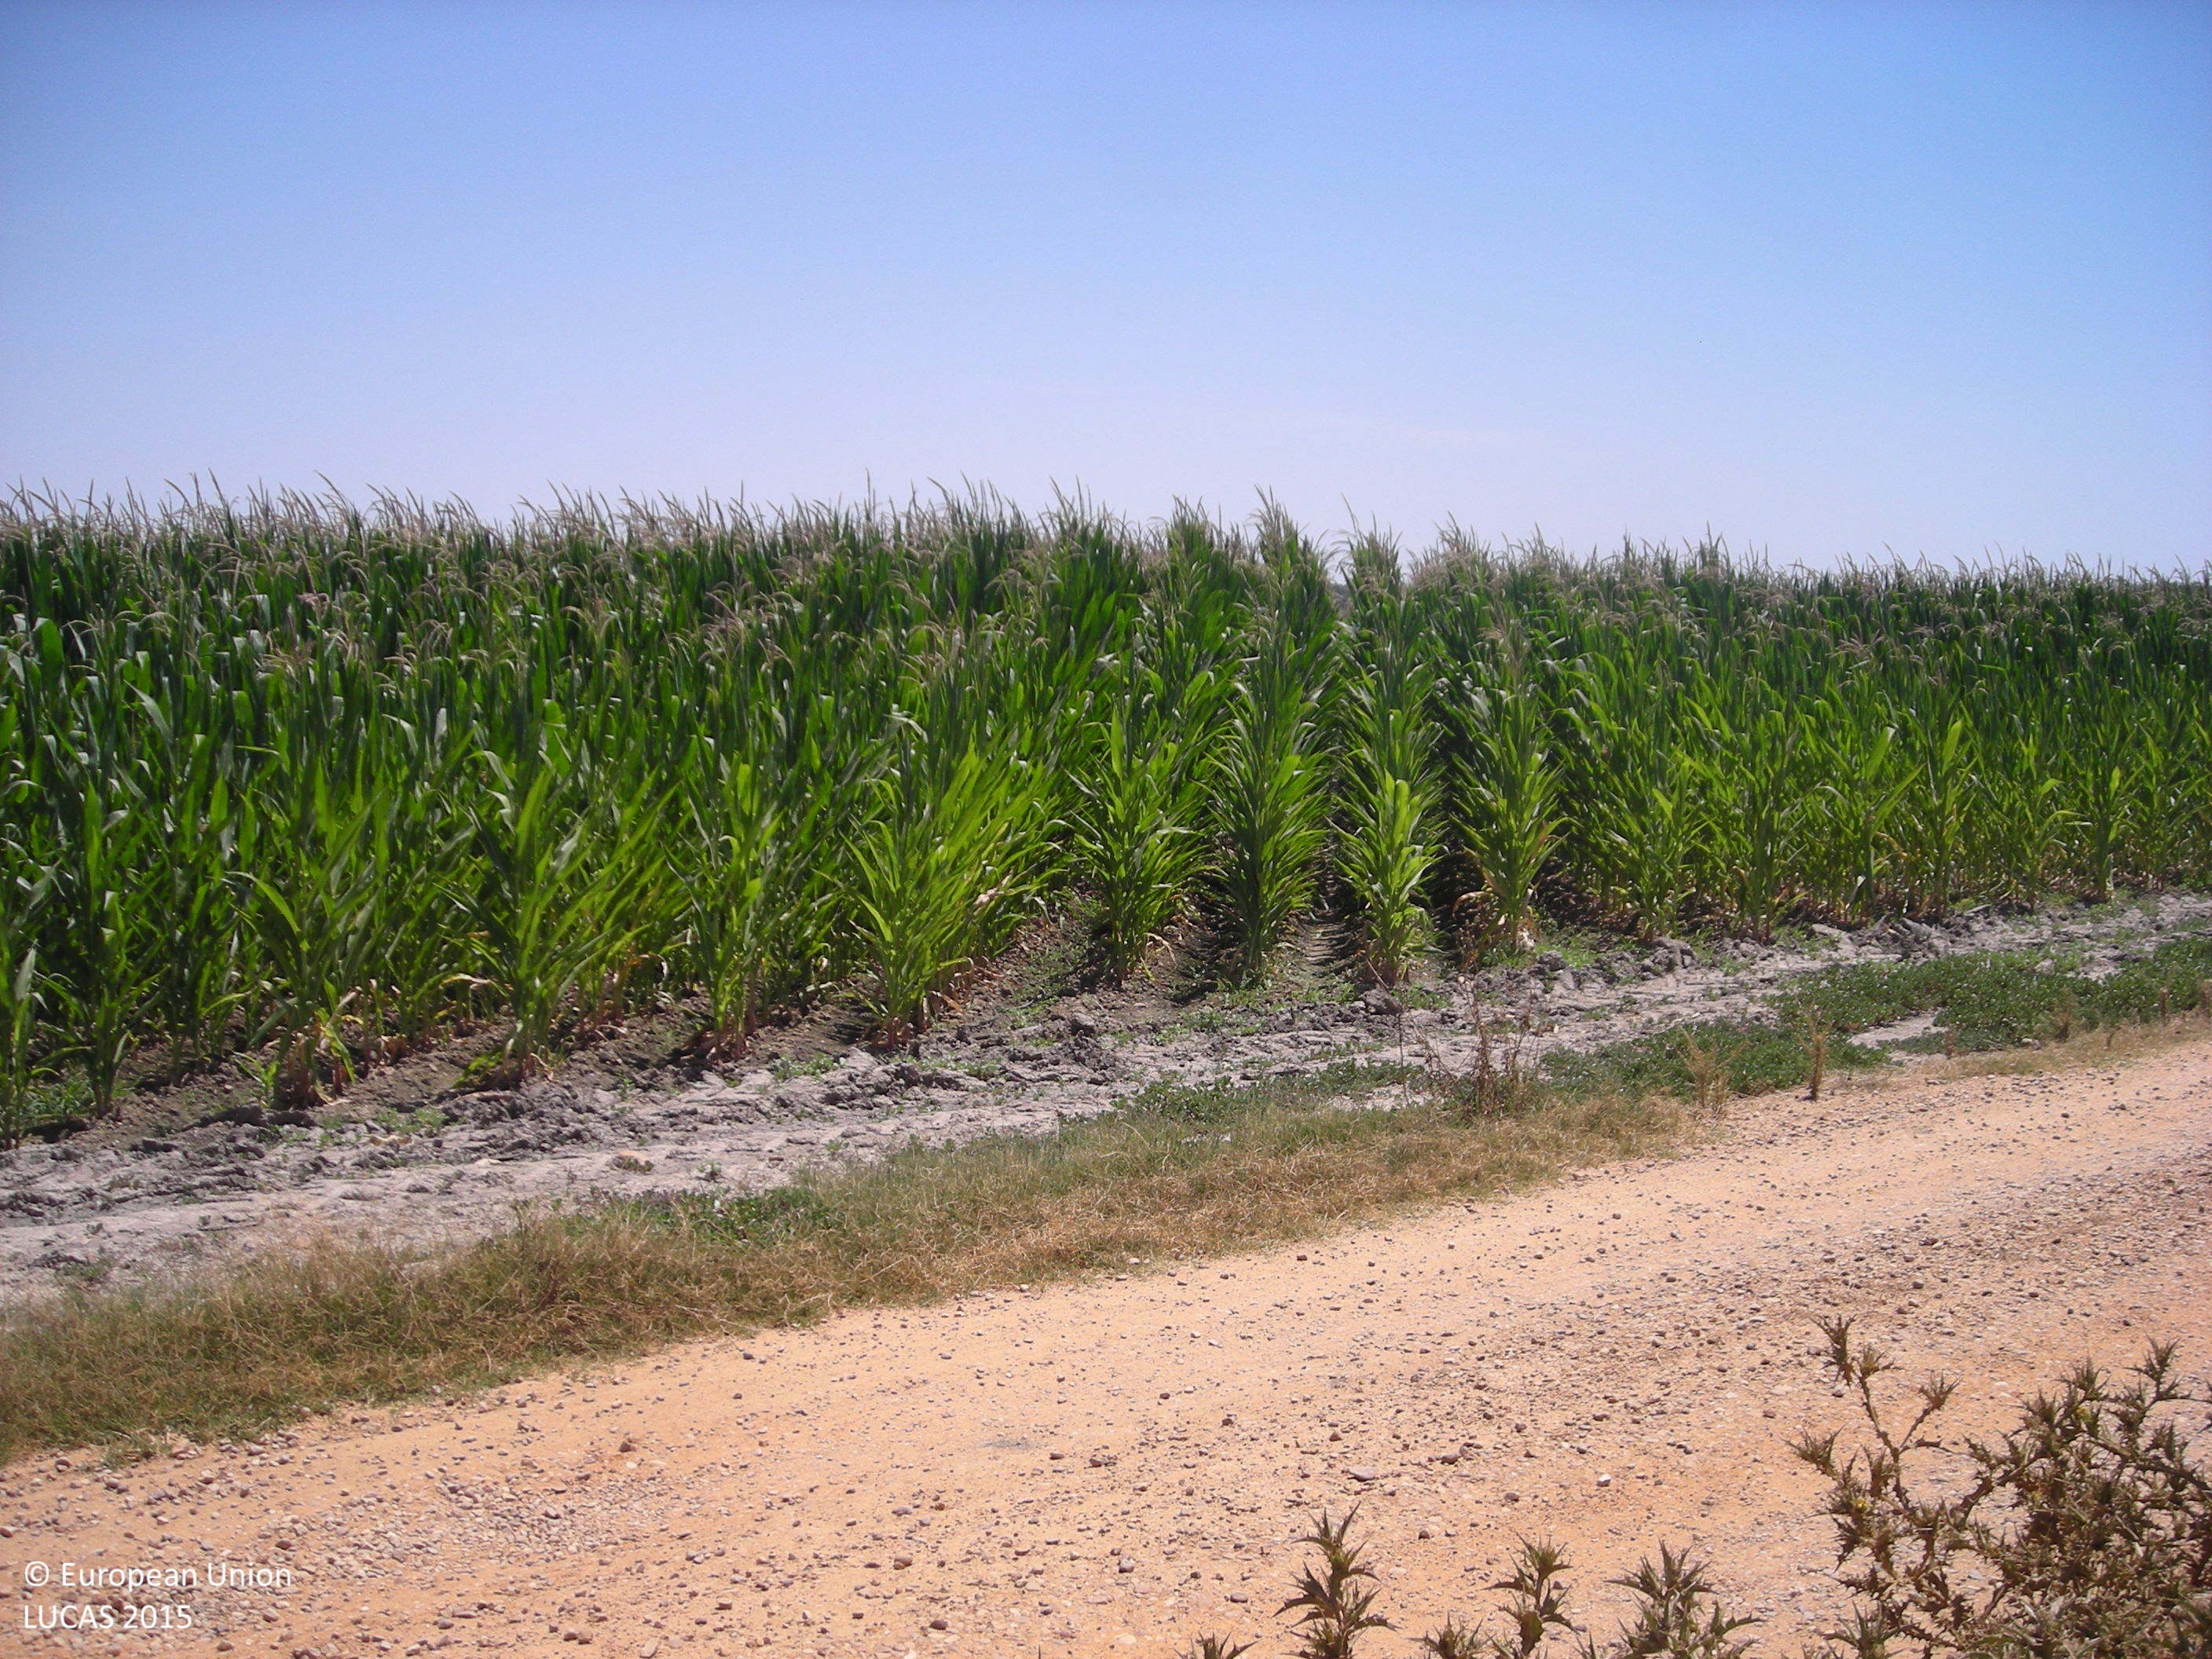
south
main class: Cropland
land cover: Other fruit trees and berries
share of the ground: > 75 %
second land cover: Other bare soil
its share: > 75 %
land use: Agriculture (excluding fallow land and kitchen gardens)
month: July
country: ES
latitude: 39.0972
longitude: -5.8576
